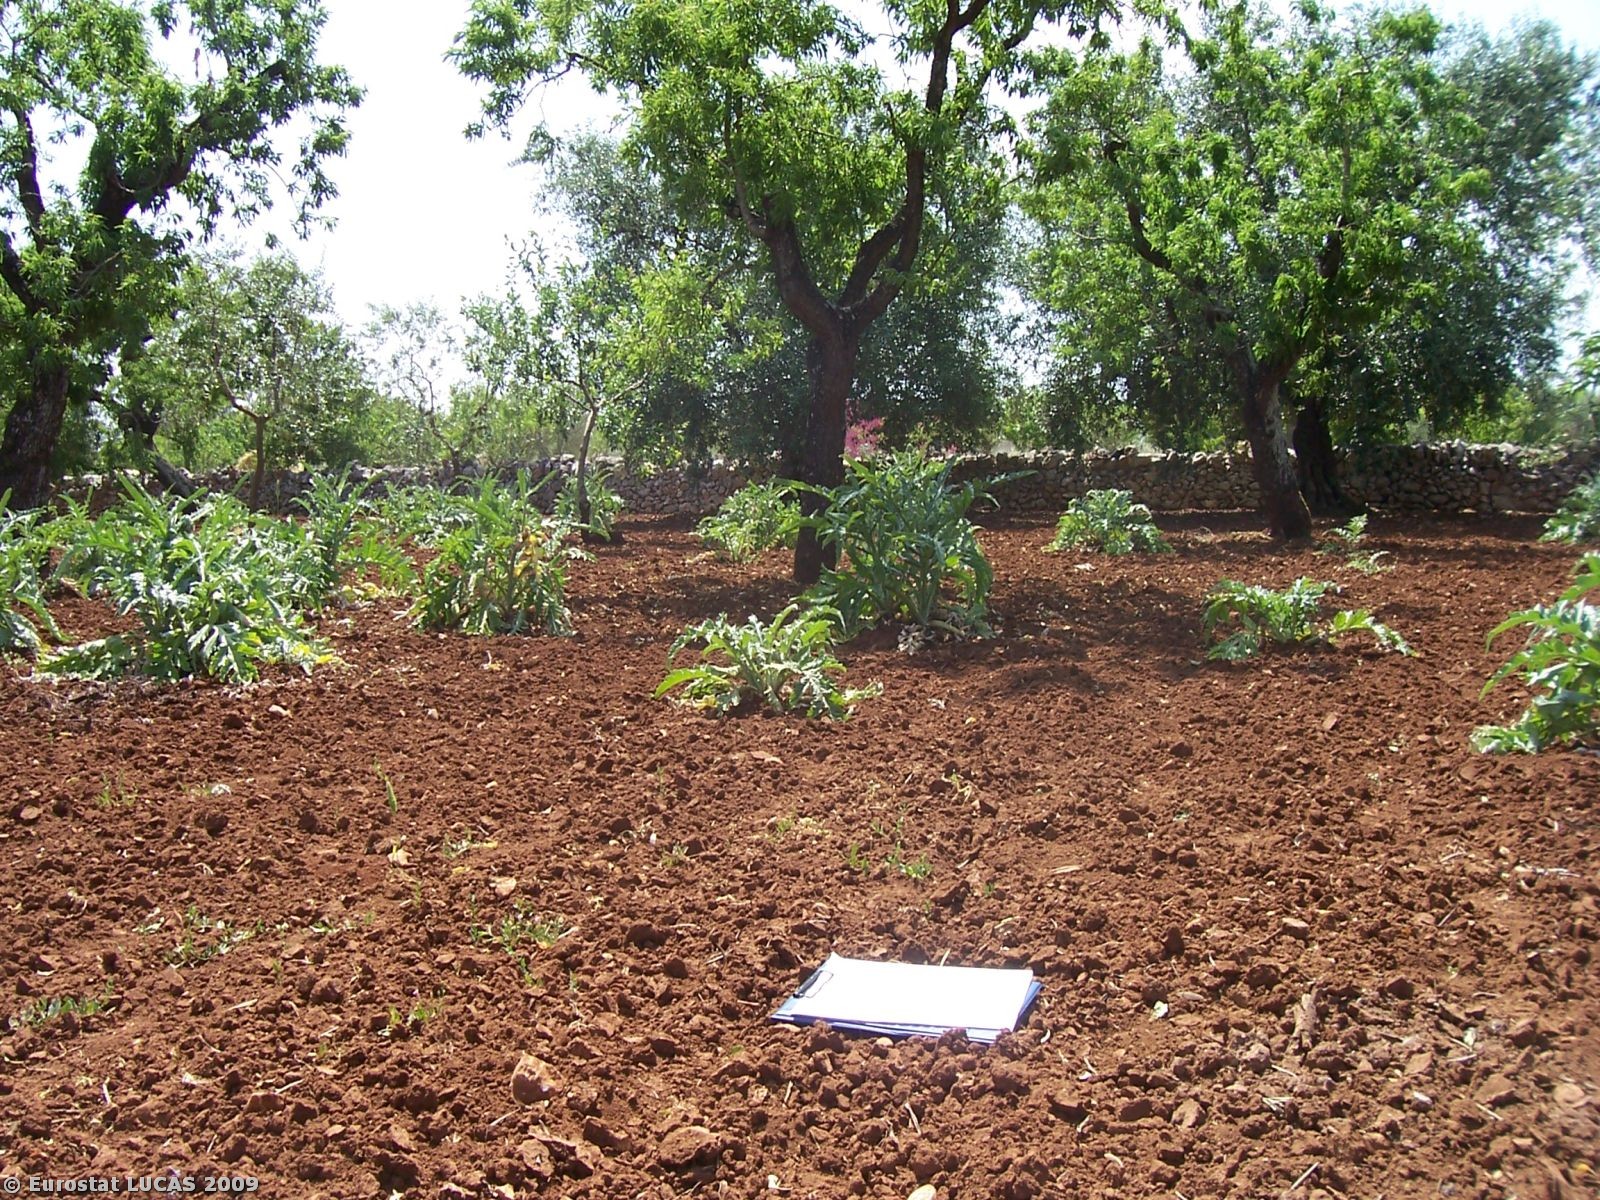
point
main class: Cropland
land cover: Olive groves
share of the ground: 50 - 75 %
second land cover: Nuts trees
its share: > 75 %
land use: Agriculture (excluding fallow land and kitchen gardens)
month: May
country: IT
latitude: 40.7809
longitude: 16.9804
